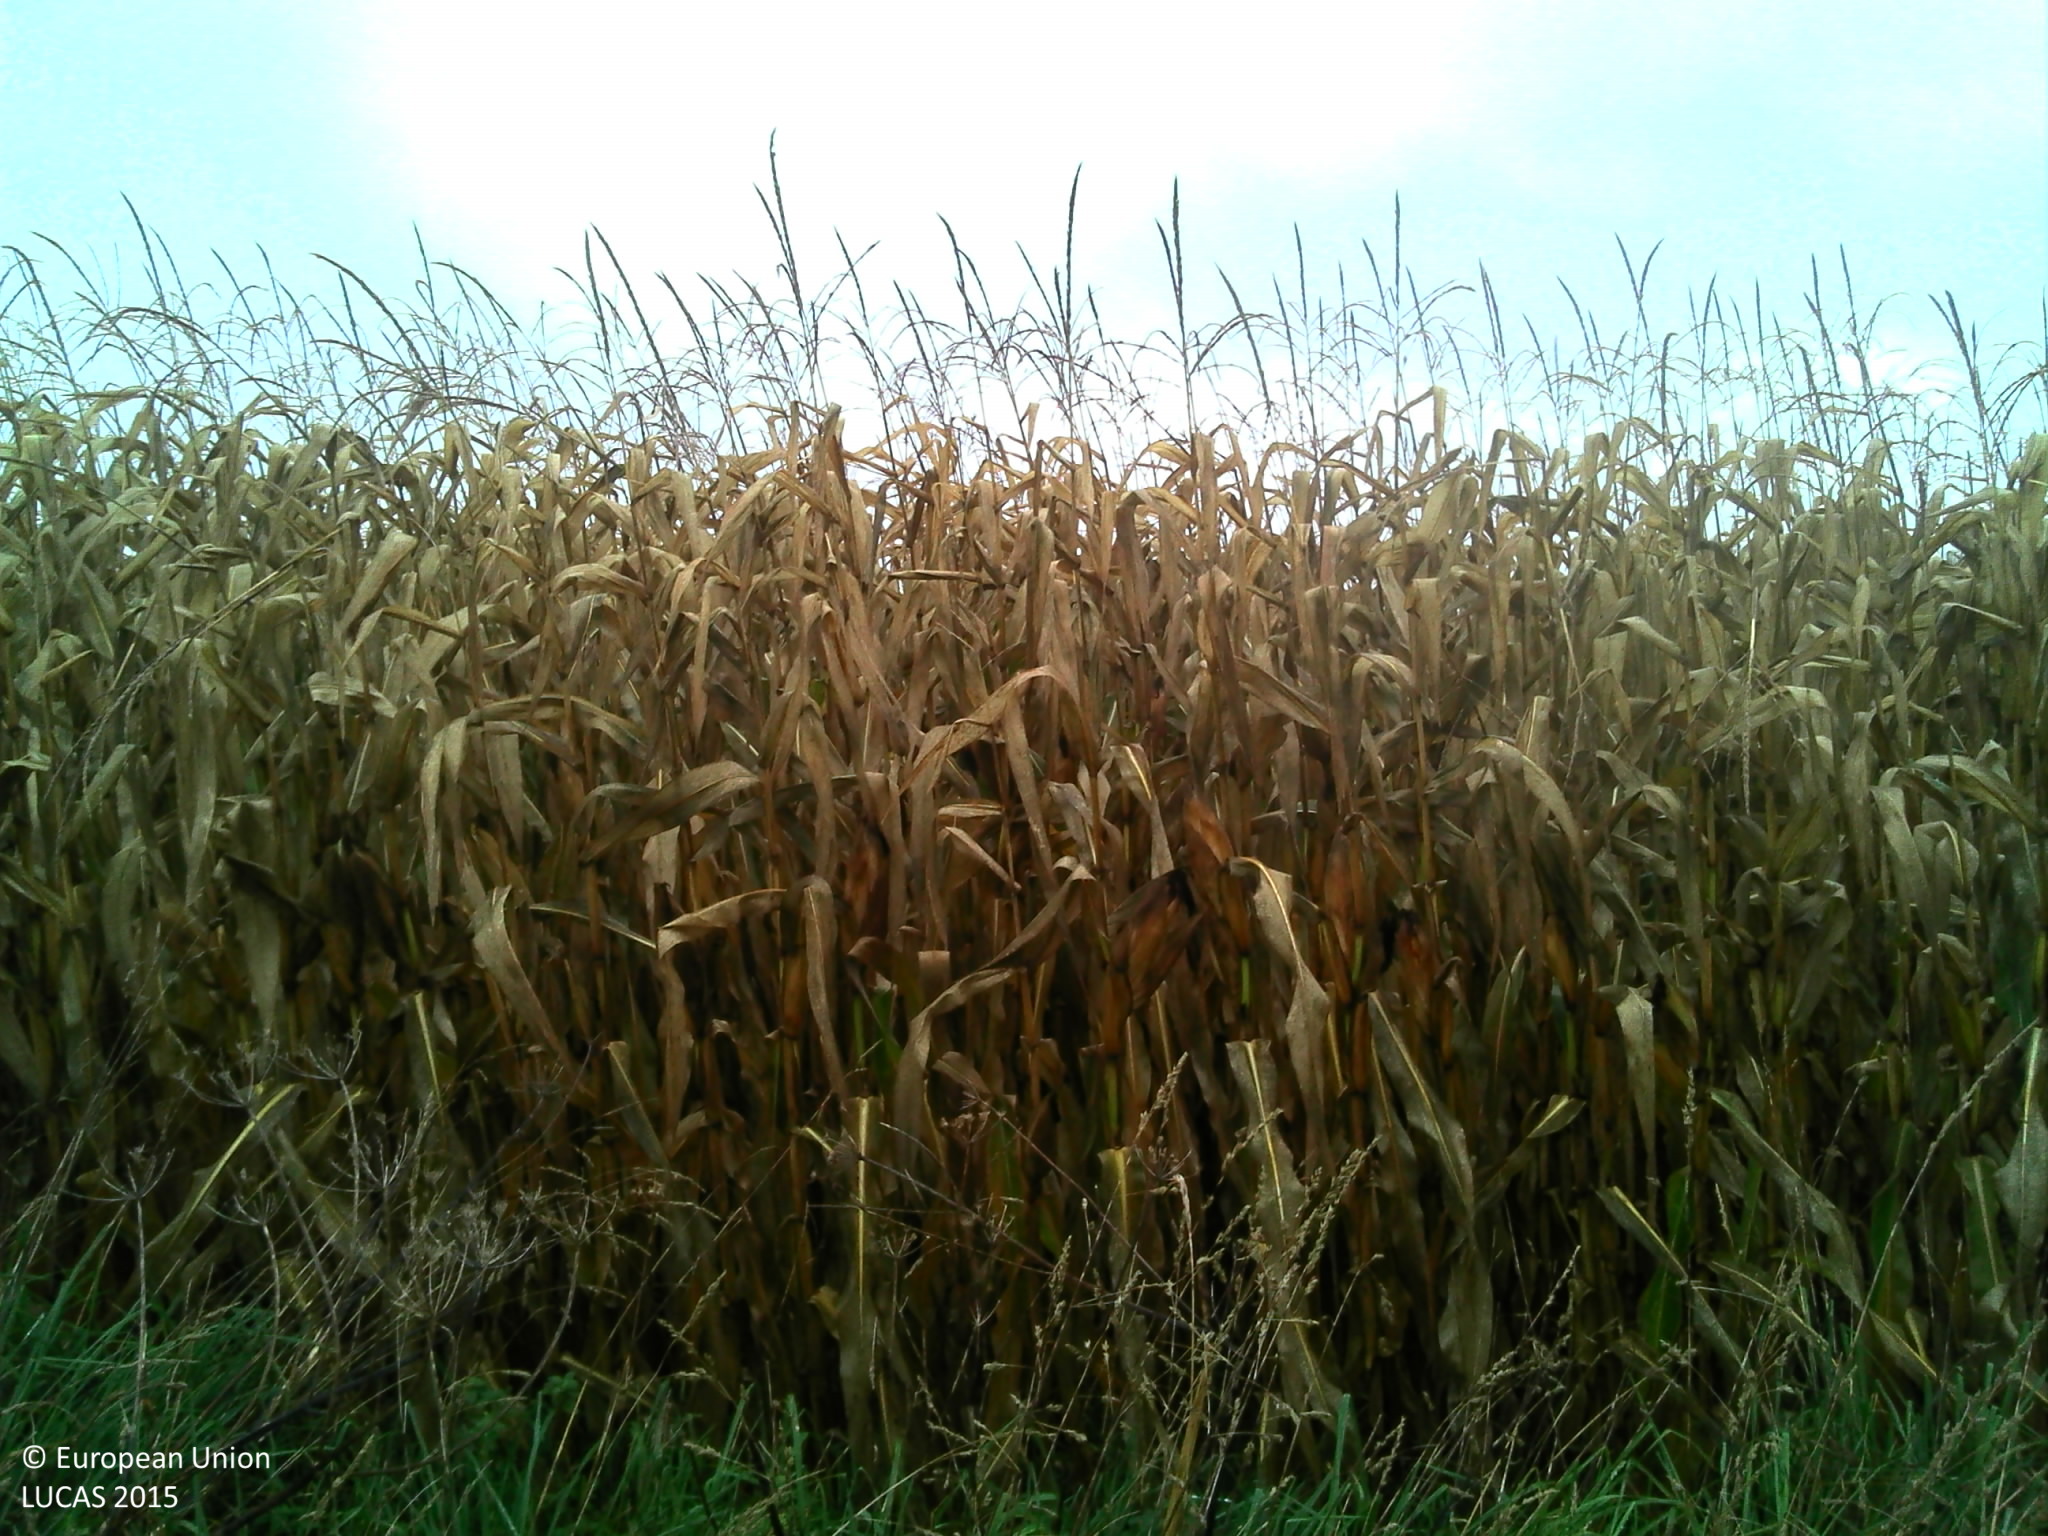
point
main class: Cropland
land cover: Maize
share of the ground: > 75 %
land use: Agriculture (excluding fallow land and kitchen gardens)
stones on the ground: < 10 %
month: November
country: FR
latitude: 47.9437
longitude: -3.2865
